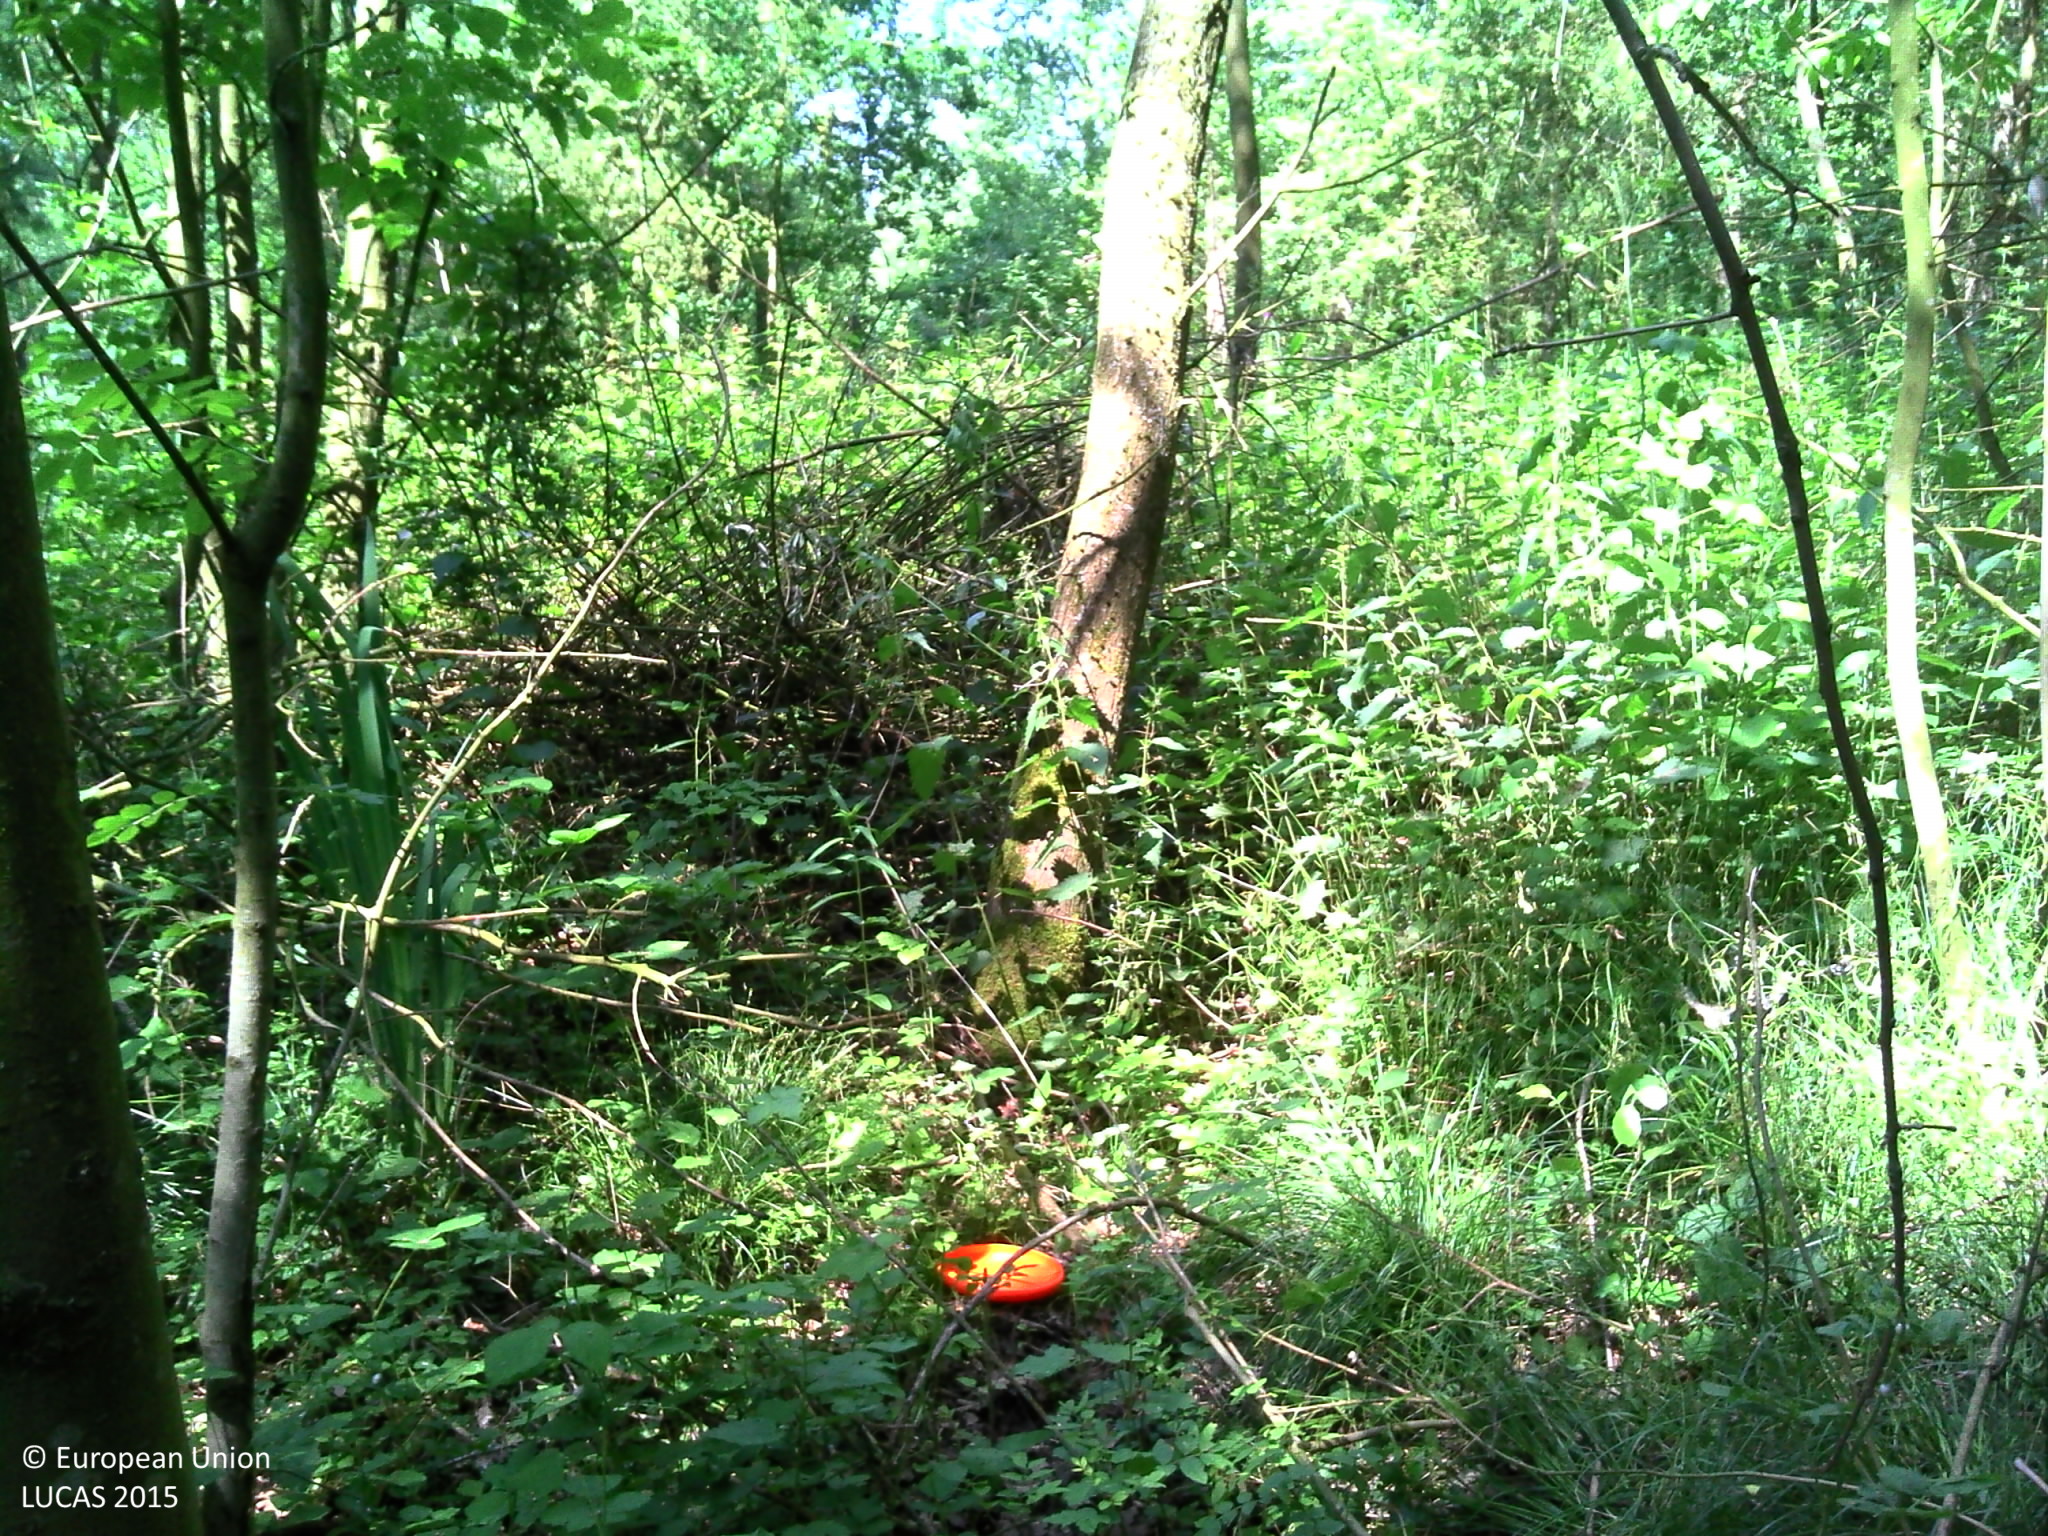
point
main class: Woodland
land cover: Broadleaved woodland
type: acidophilous oak and oak-birch forest
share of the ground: > 75 %
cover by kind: broadleaved forest trees 100 %
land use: Forestry
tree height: > 5 m
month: June
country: BE
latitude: 51.0340
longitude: 3.9619
